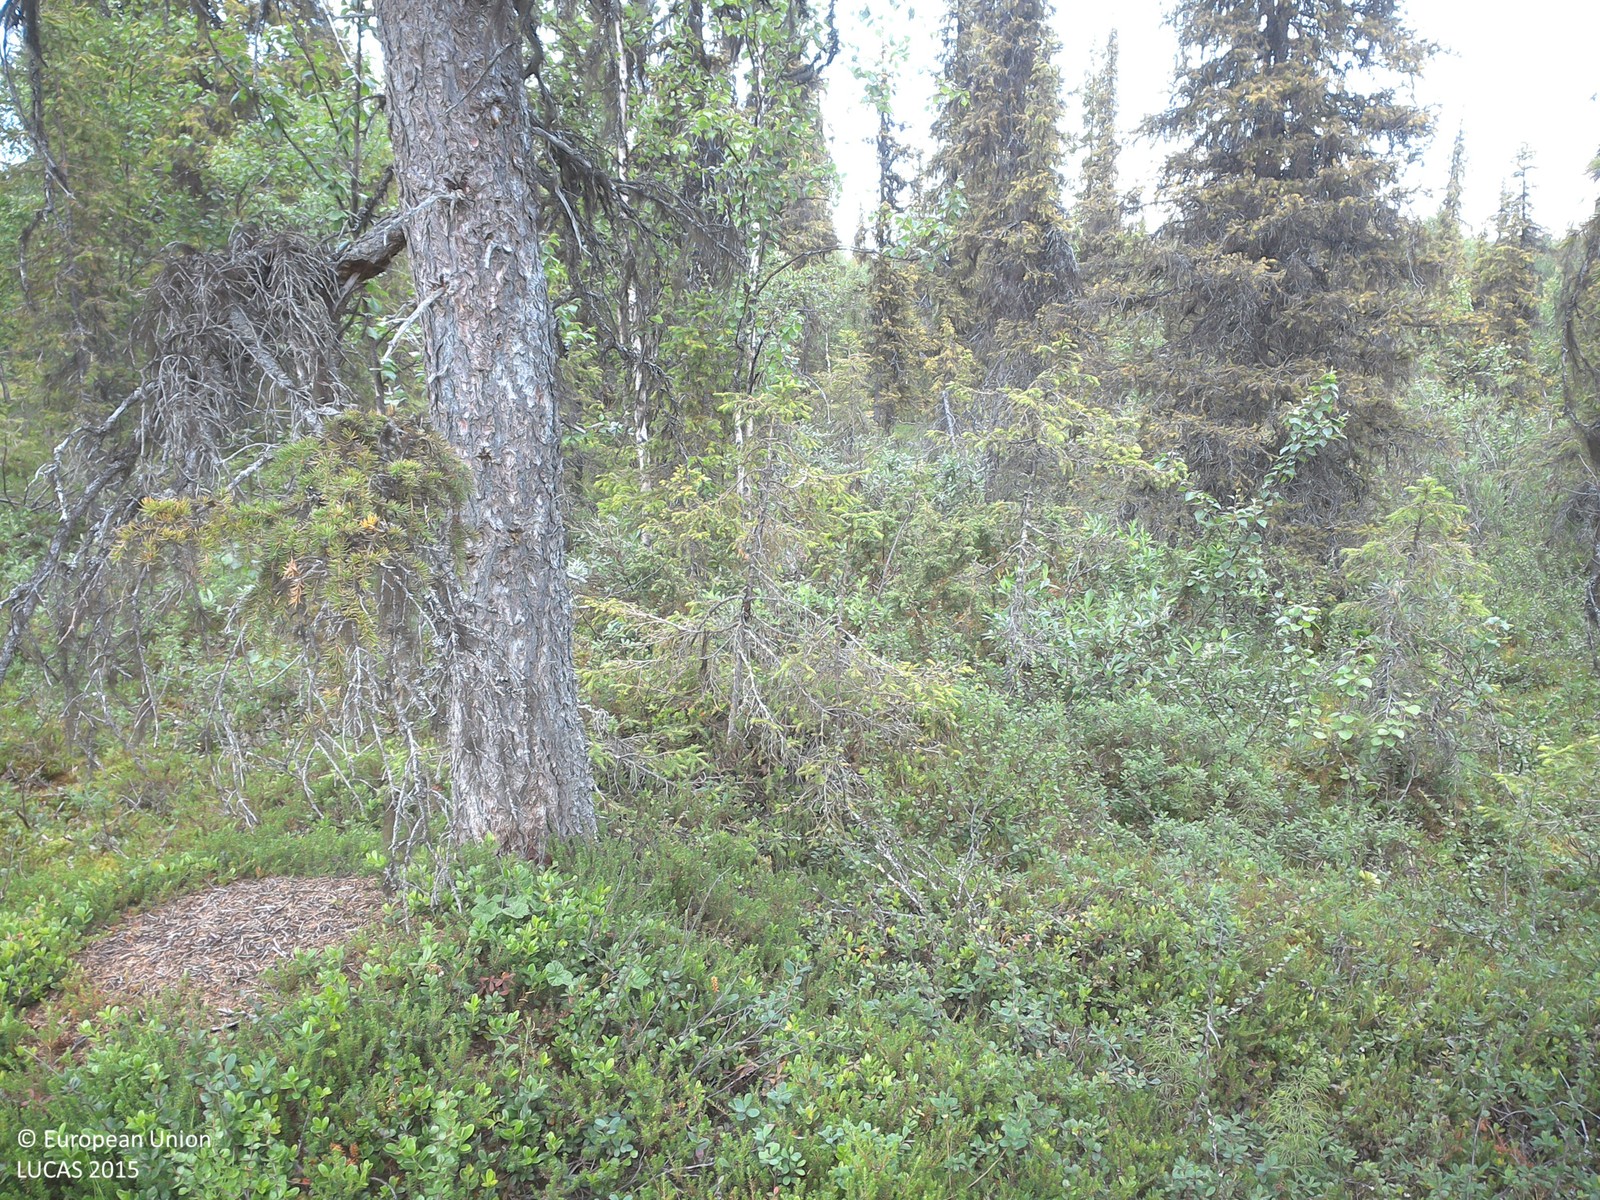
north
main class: Woodland
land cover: Spruce dominated mixed woodland
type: boreal forest
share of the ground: 10 - 25 %
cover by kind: shrubs 70 %, coniferous forest trees 15 %, lichens and mosses 10 %, broadleaved forest trees 5 %
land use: Forestry
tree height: > 5 m
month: July
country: SE
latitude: 67.4780
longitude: 22.0491
